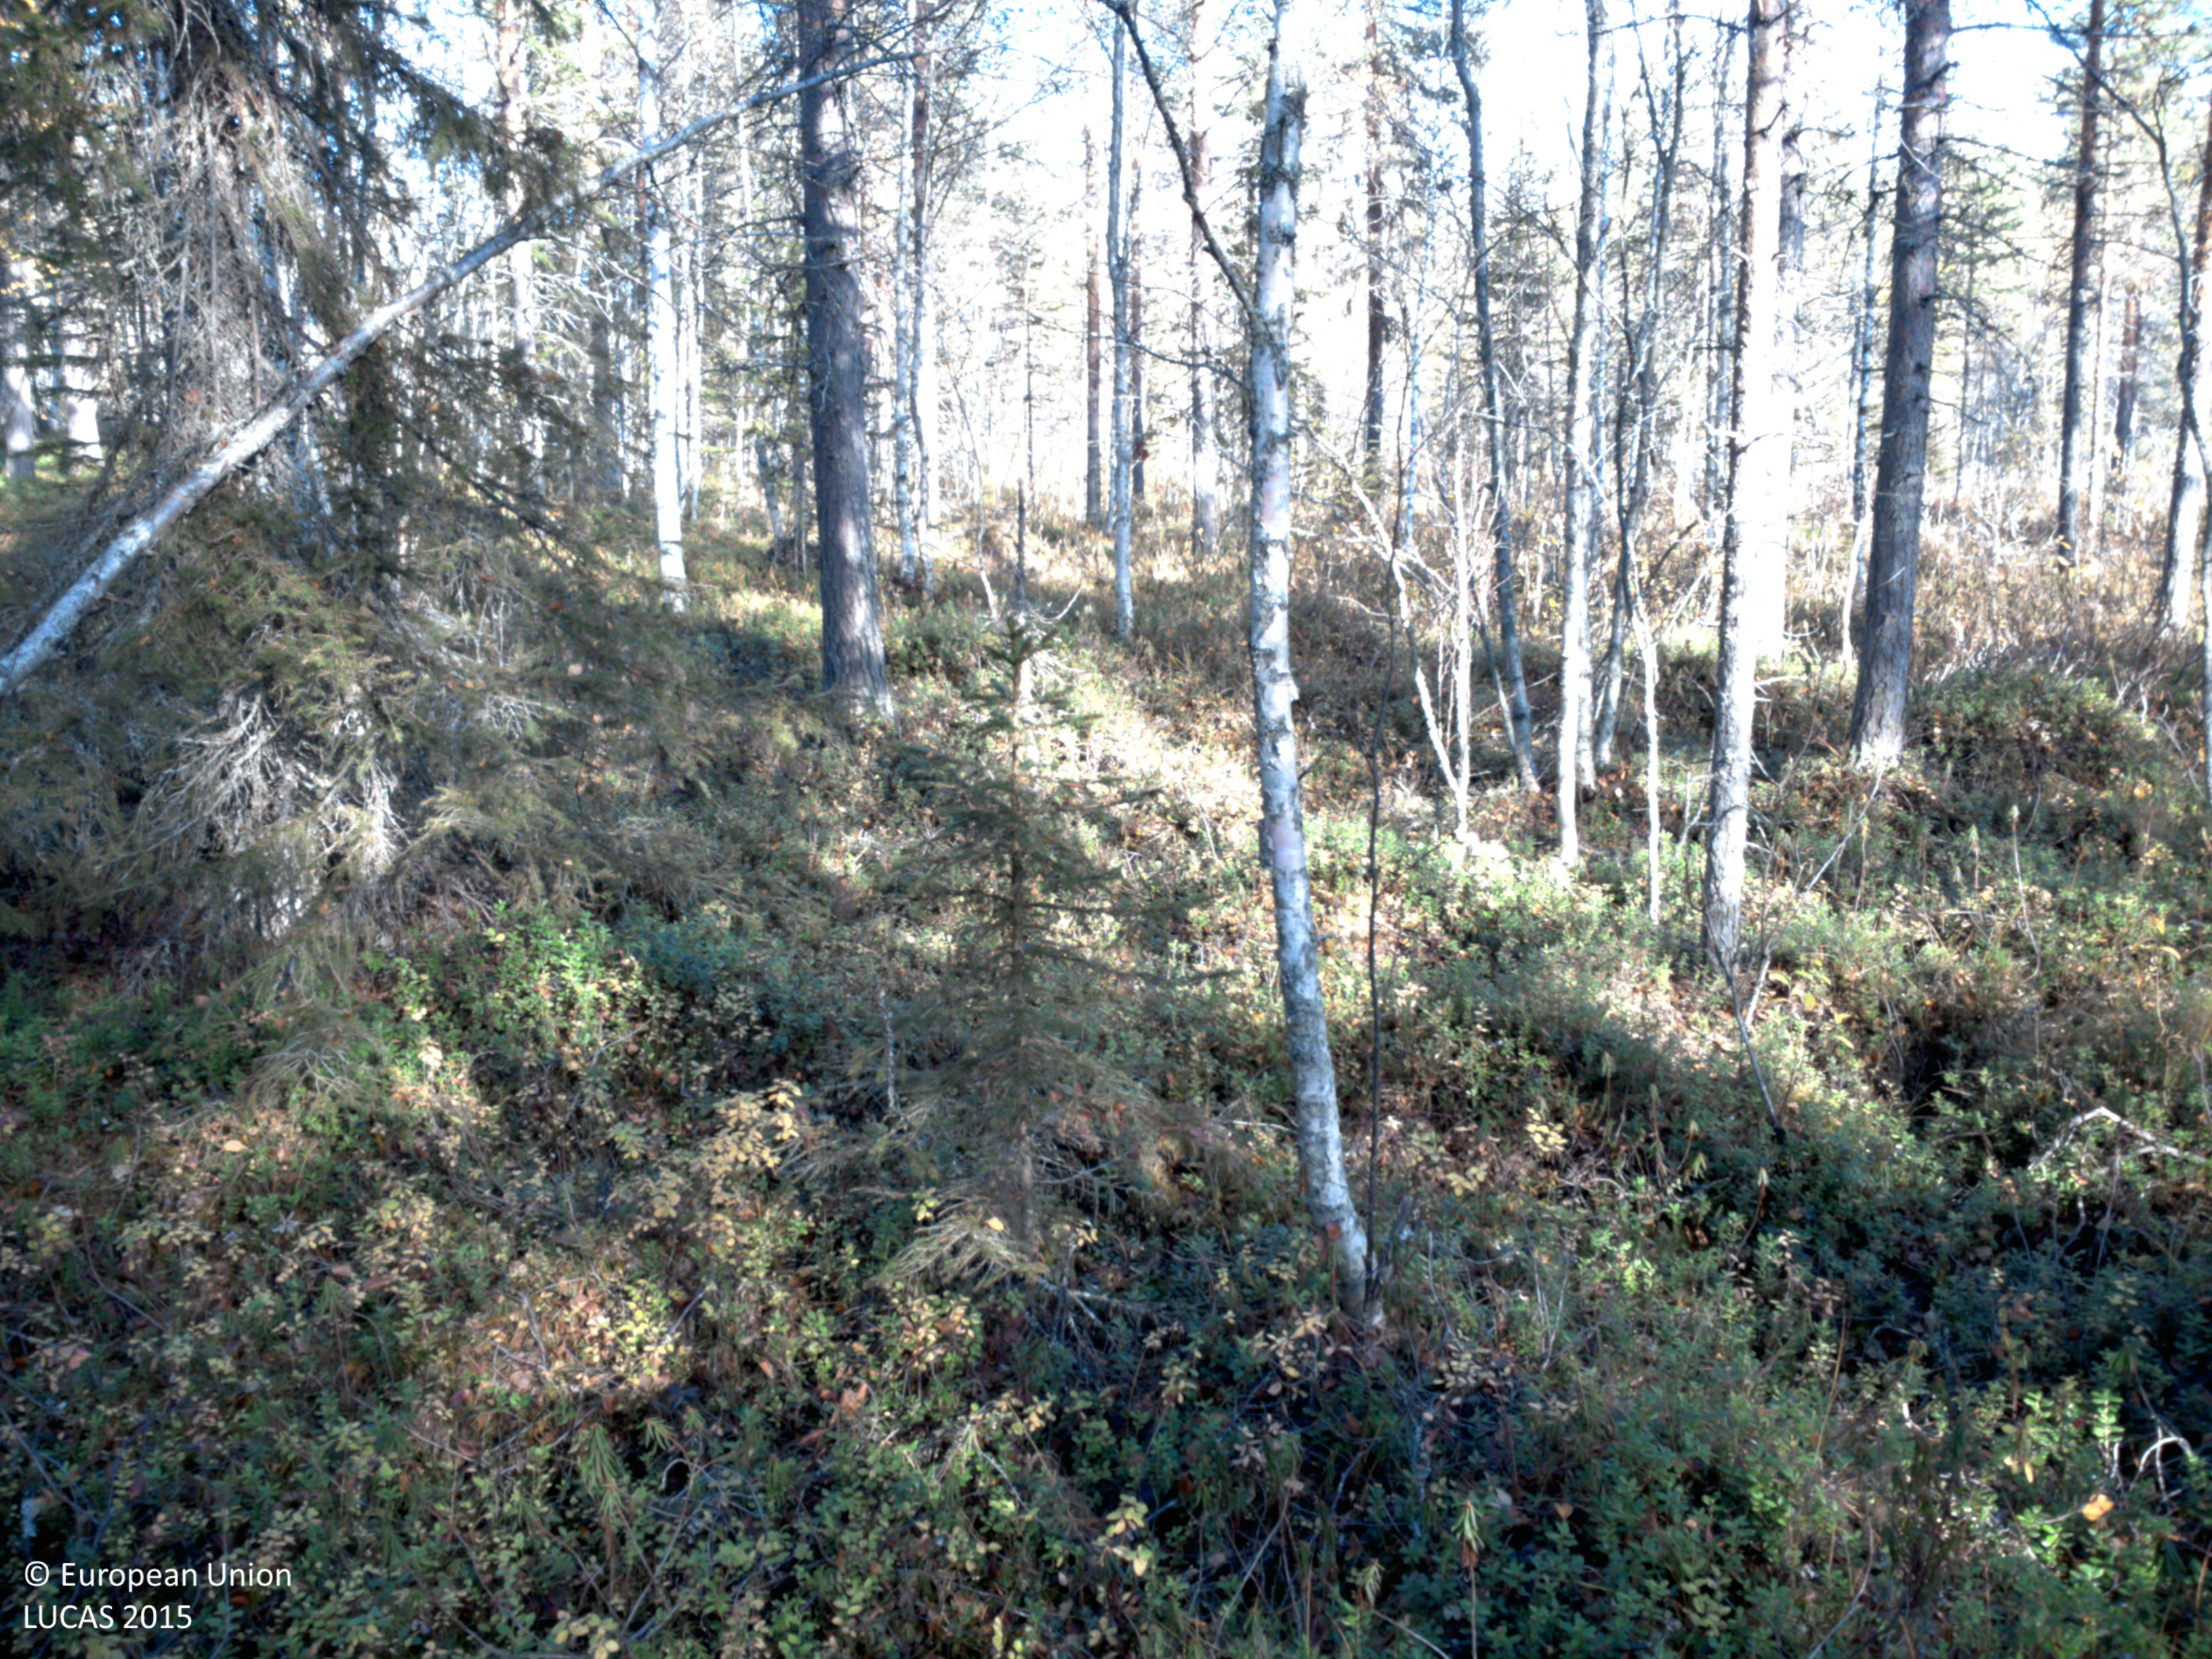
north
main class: Woodland
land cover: Pine dominated mixed woodland
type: boreal forest
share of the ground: 50 - 75 %
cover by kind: coniferous forest trees 45 %, shrubs 35 %, broadleaved forest trees 15 %, lichens and mosses 5 %
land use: Forestry
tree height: > 5 m
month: September
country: SE
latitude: 64.8606
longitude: 18.5097
